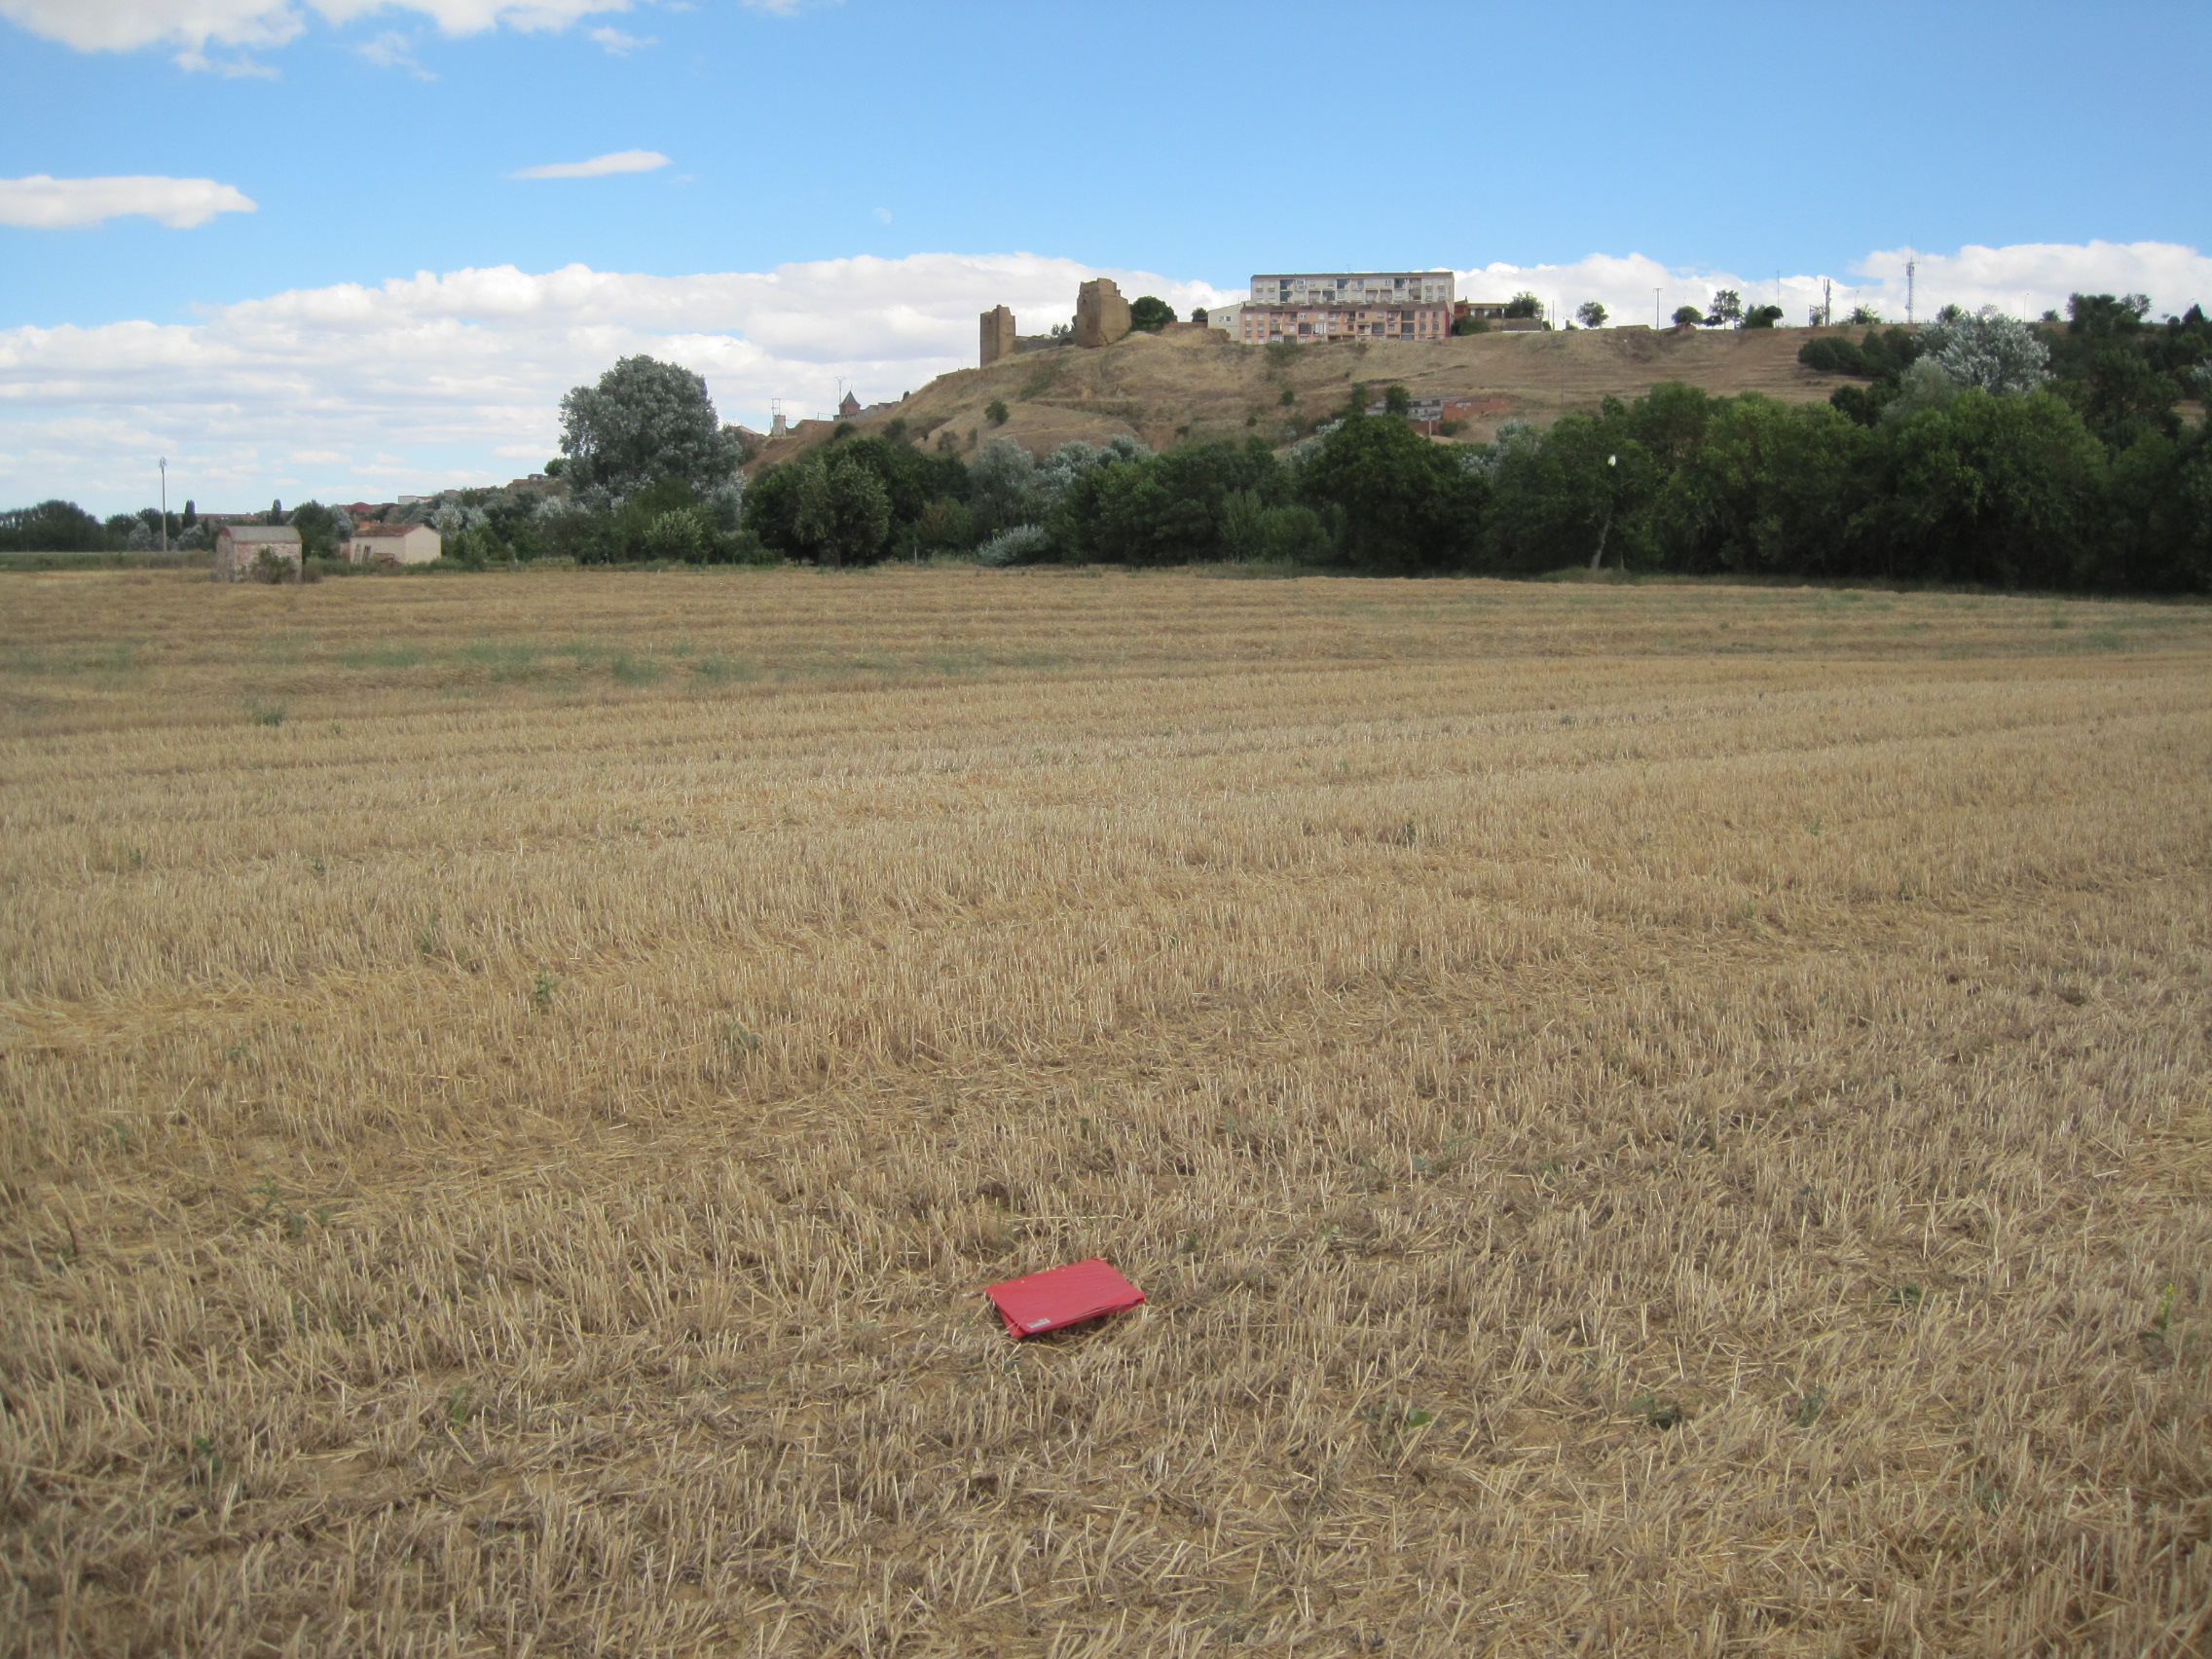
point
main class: Cropland
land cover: Common wheat
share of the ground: < 10 %
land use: Agriculture (excluding fallow land and kitchen gardens)
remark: Harvested field
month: July
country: ES
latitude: 42.0838
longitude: -5.4530
